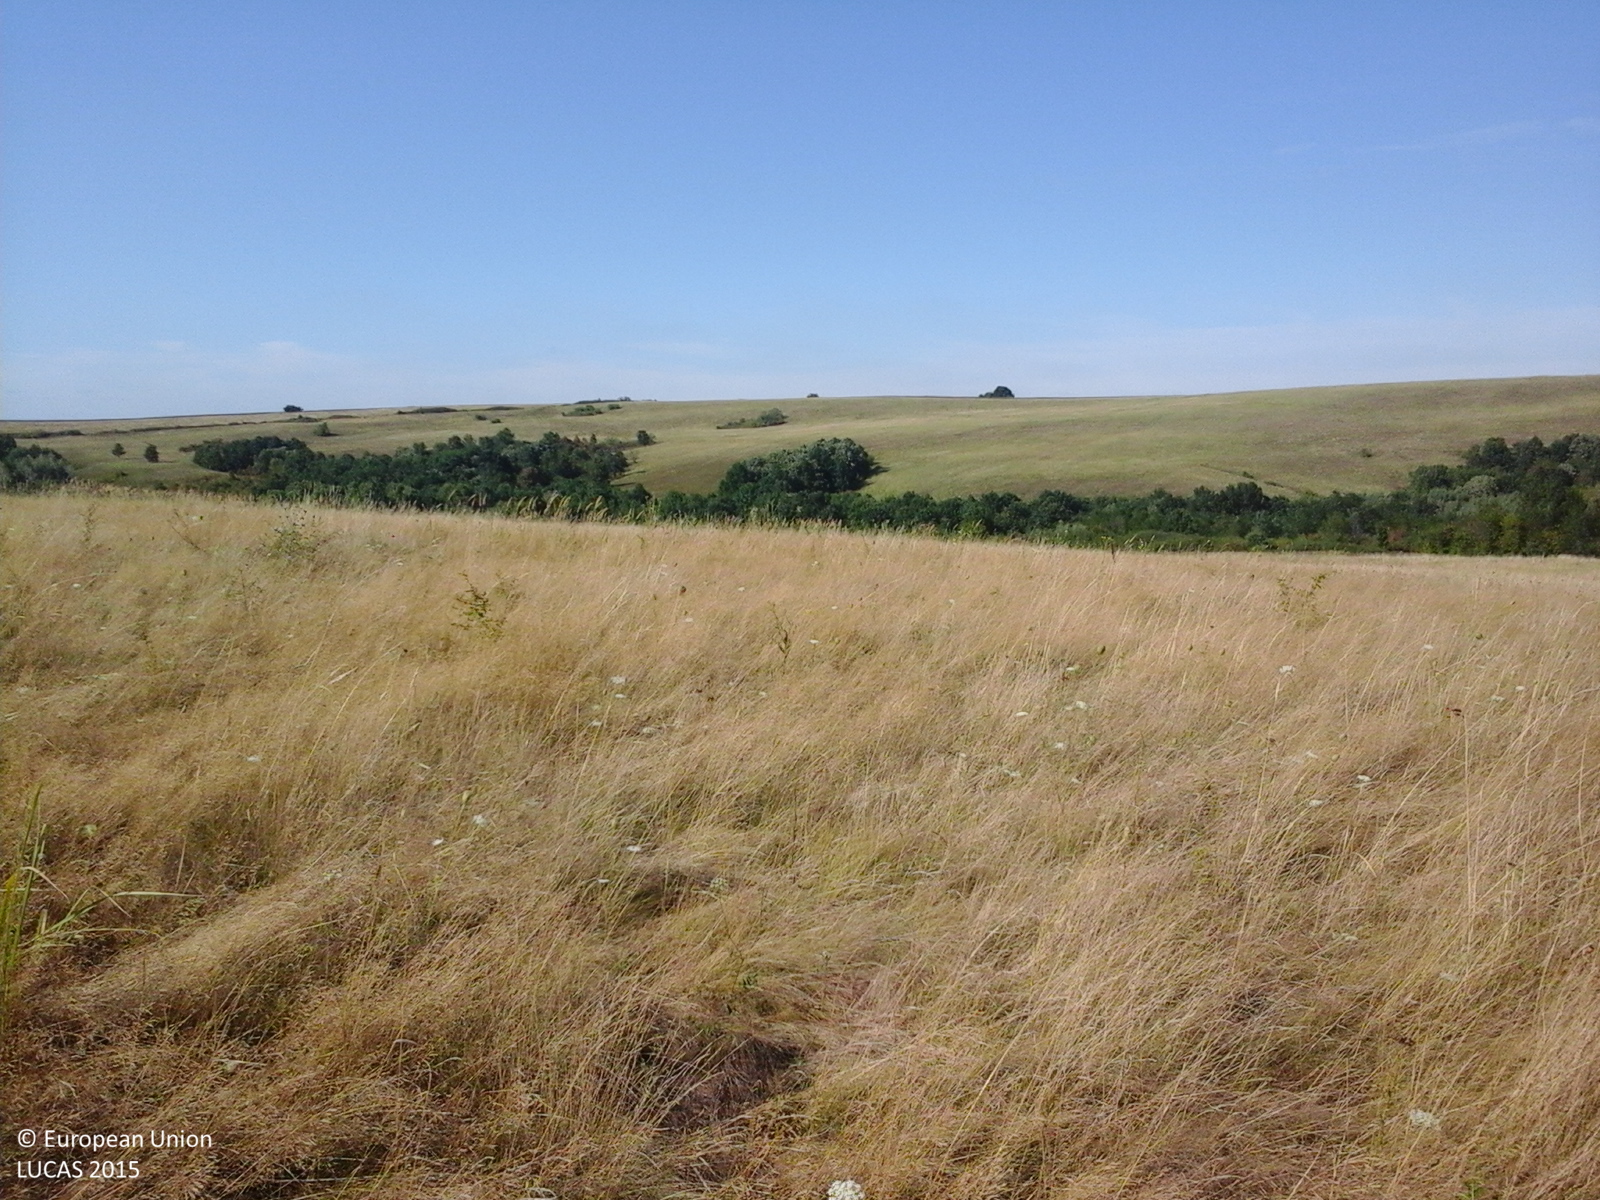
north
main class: Grassland
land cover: Grassland without tree/shrub cover
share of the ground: > 75 %
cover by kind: herbaceous plants 100 %
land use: Agriculture (excluding fallow land and kitchen gardens)
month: August
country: RO
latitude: 45.1423
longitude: 21.5398
